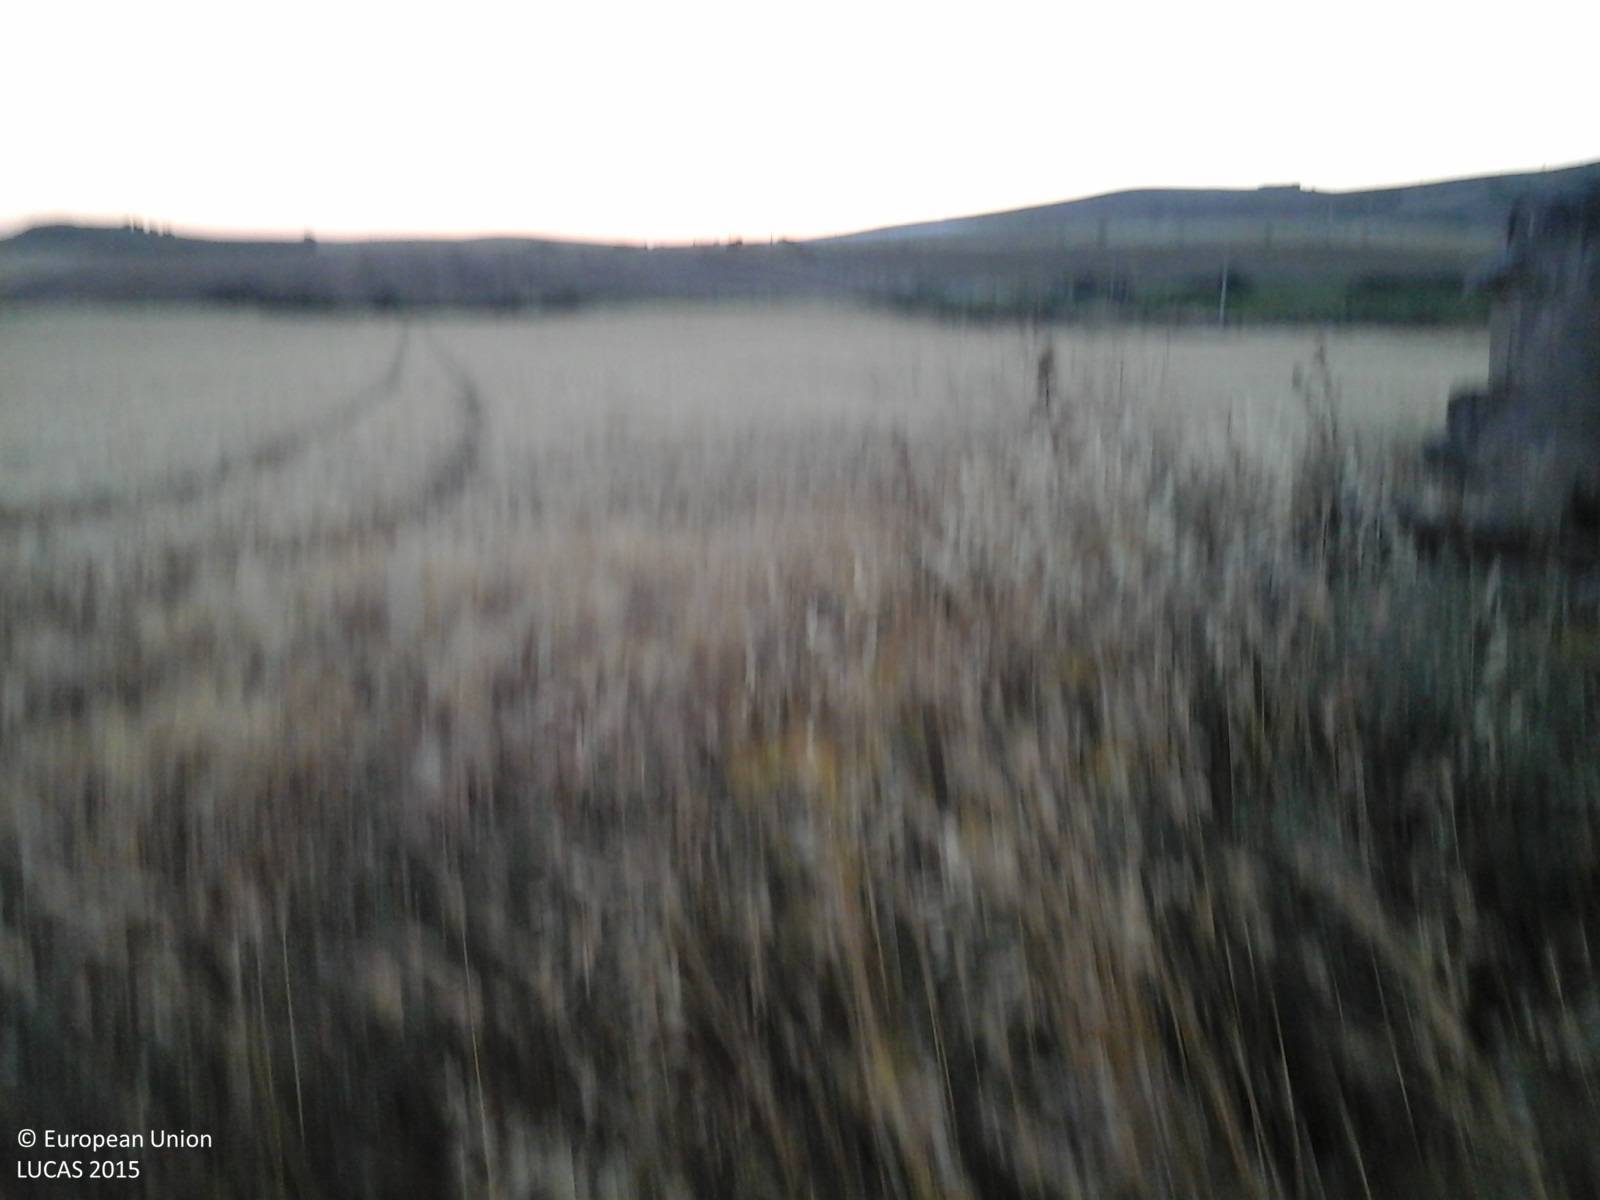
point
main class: Cropland
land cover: Durum wheat
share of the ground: > 75 %
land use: Agriculture (excluding fallow land and kitchen gardens)
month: June
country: IT
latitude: 37.9434
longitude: 12.7677
